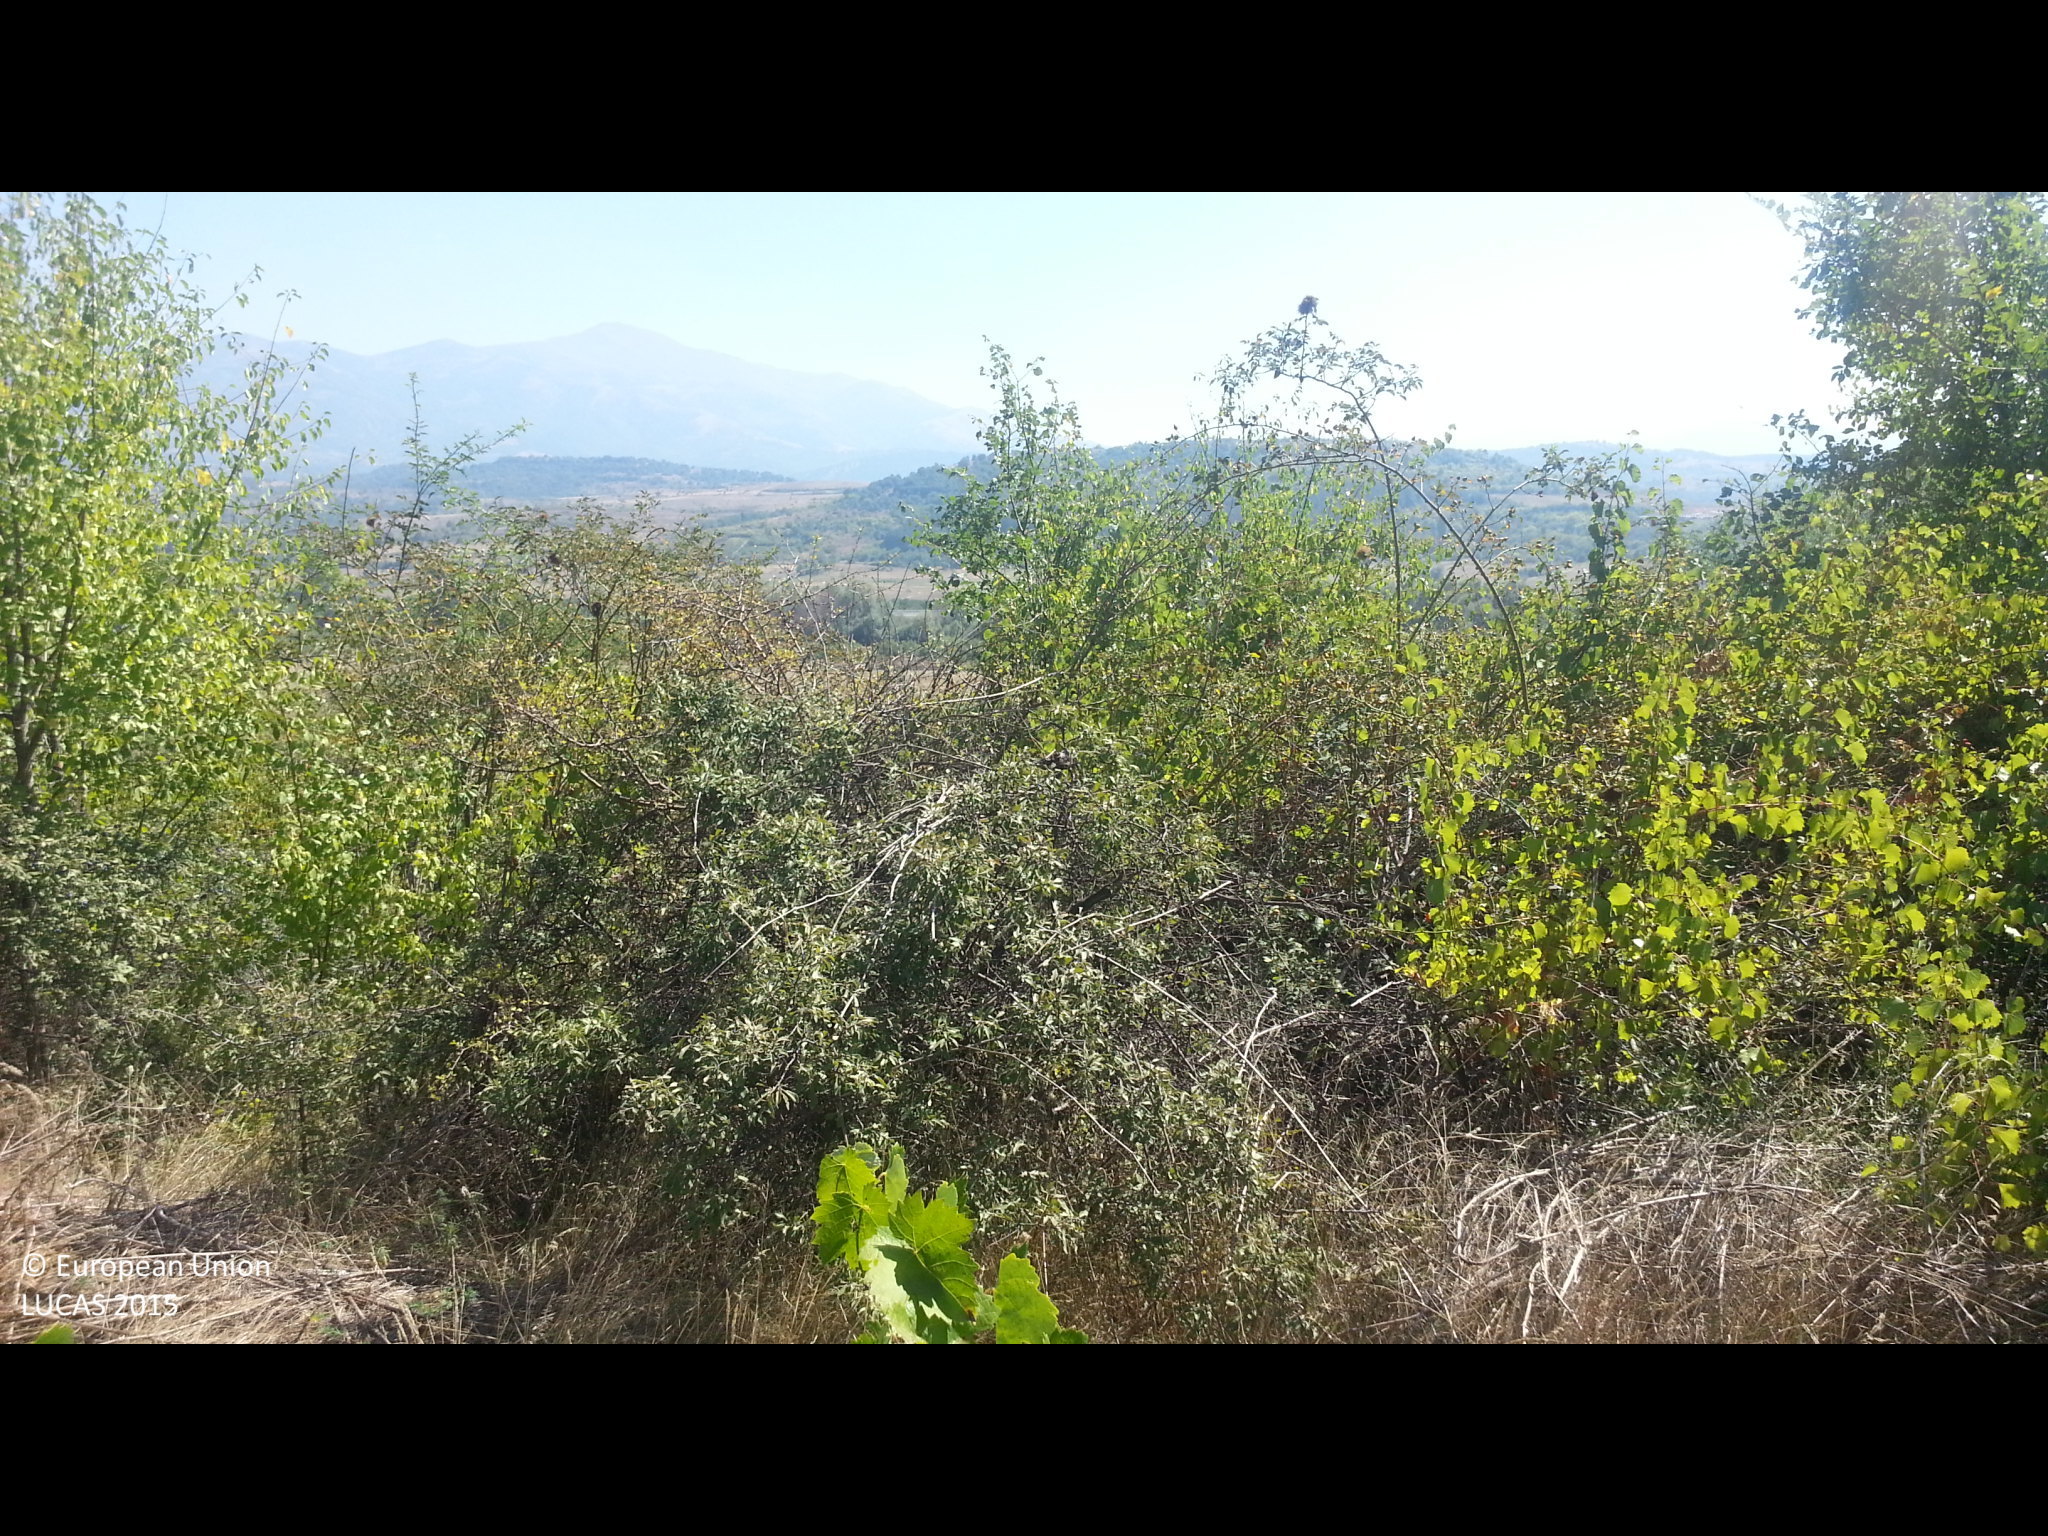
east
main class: Cropland
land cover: Vineyards
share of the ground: 25 - 50 %
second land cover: Spontaneously vegetated surfaces
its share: 50 - 75 %
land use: Agriculture (excluding fallow land and kitchen gardens)
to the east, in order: Vineyards; Spontaneously vegetated surfaces; Abandoned hedges; Vineyards; Abandoned hedges; Vineyards; Broadleaved woodland; Grass margins; Tracks; Common wheat
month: September
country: BG
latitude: 42.1726
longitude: 23.0386
